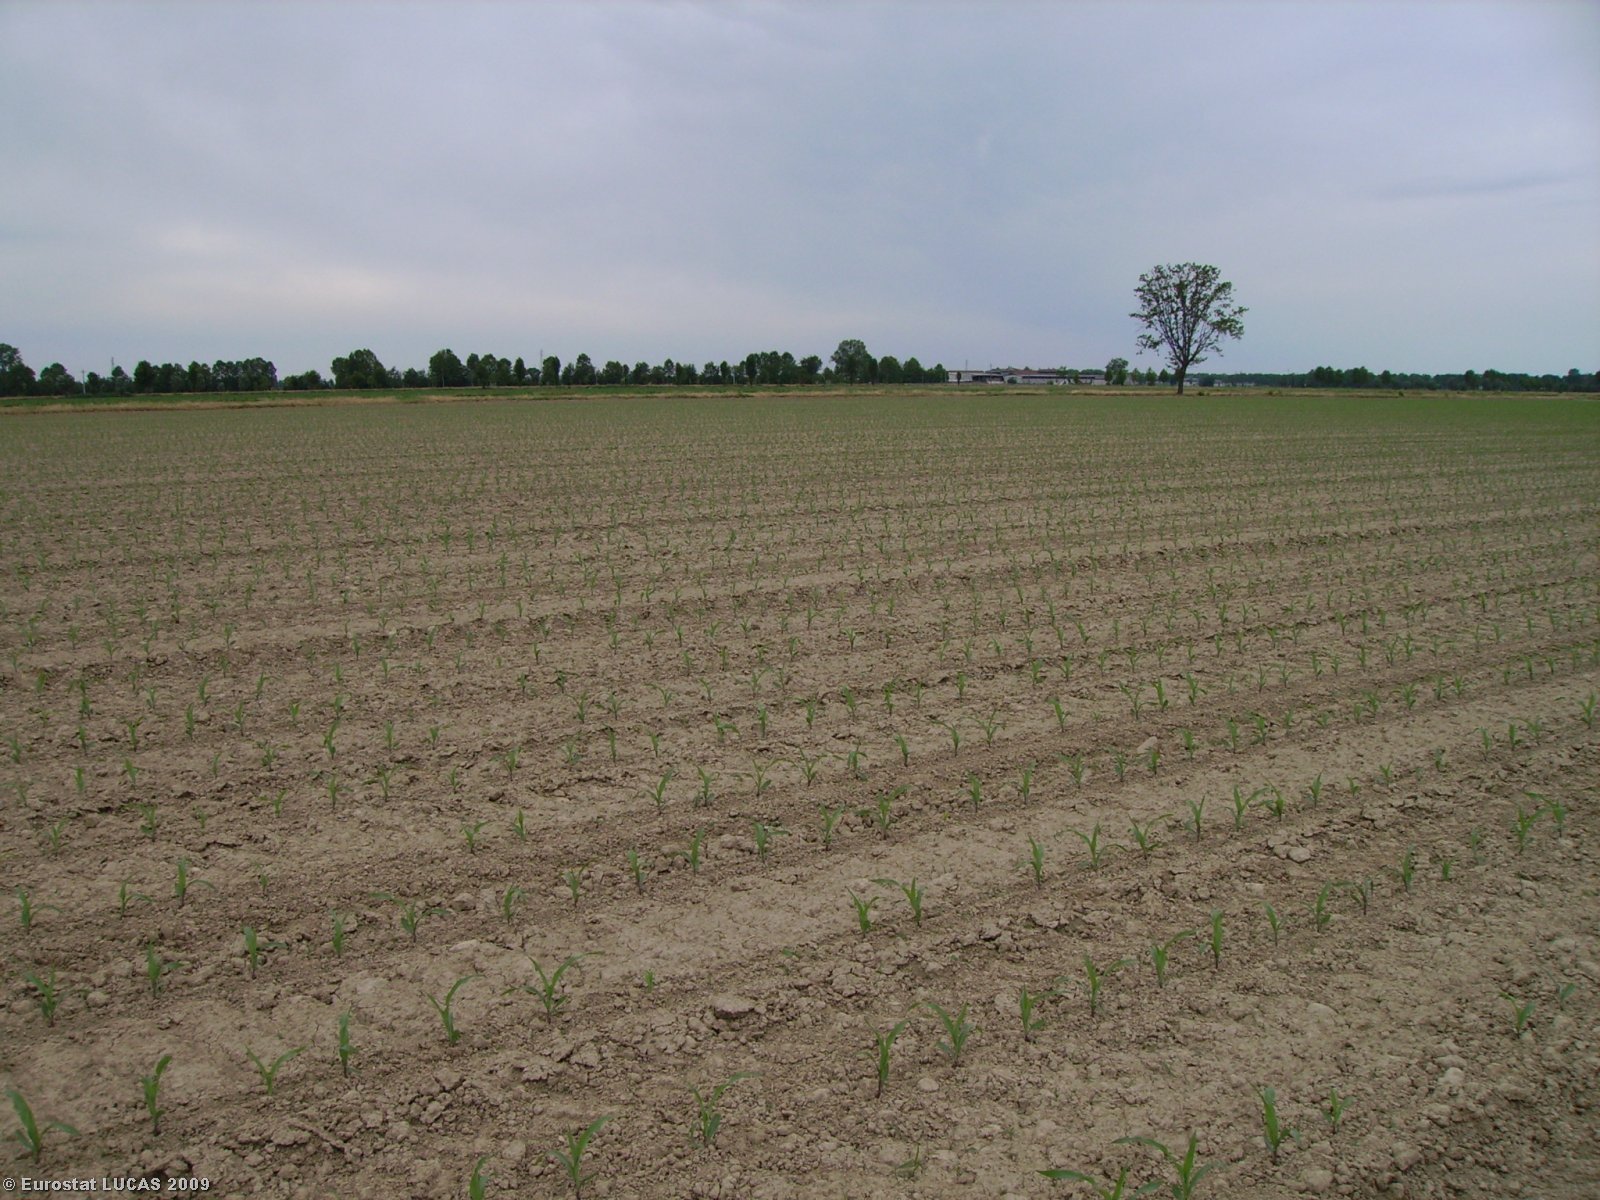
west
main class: Cropland
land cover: Maize
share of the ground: < 10 %
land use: Agriculture (excluding fallow land and kitchen gardens)
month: May
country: IT
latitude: 45.2330
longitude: 9.5296
